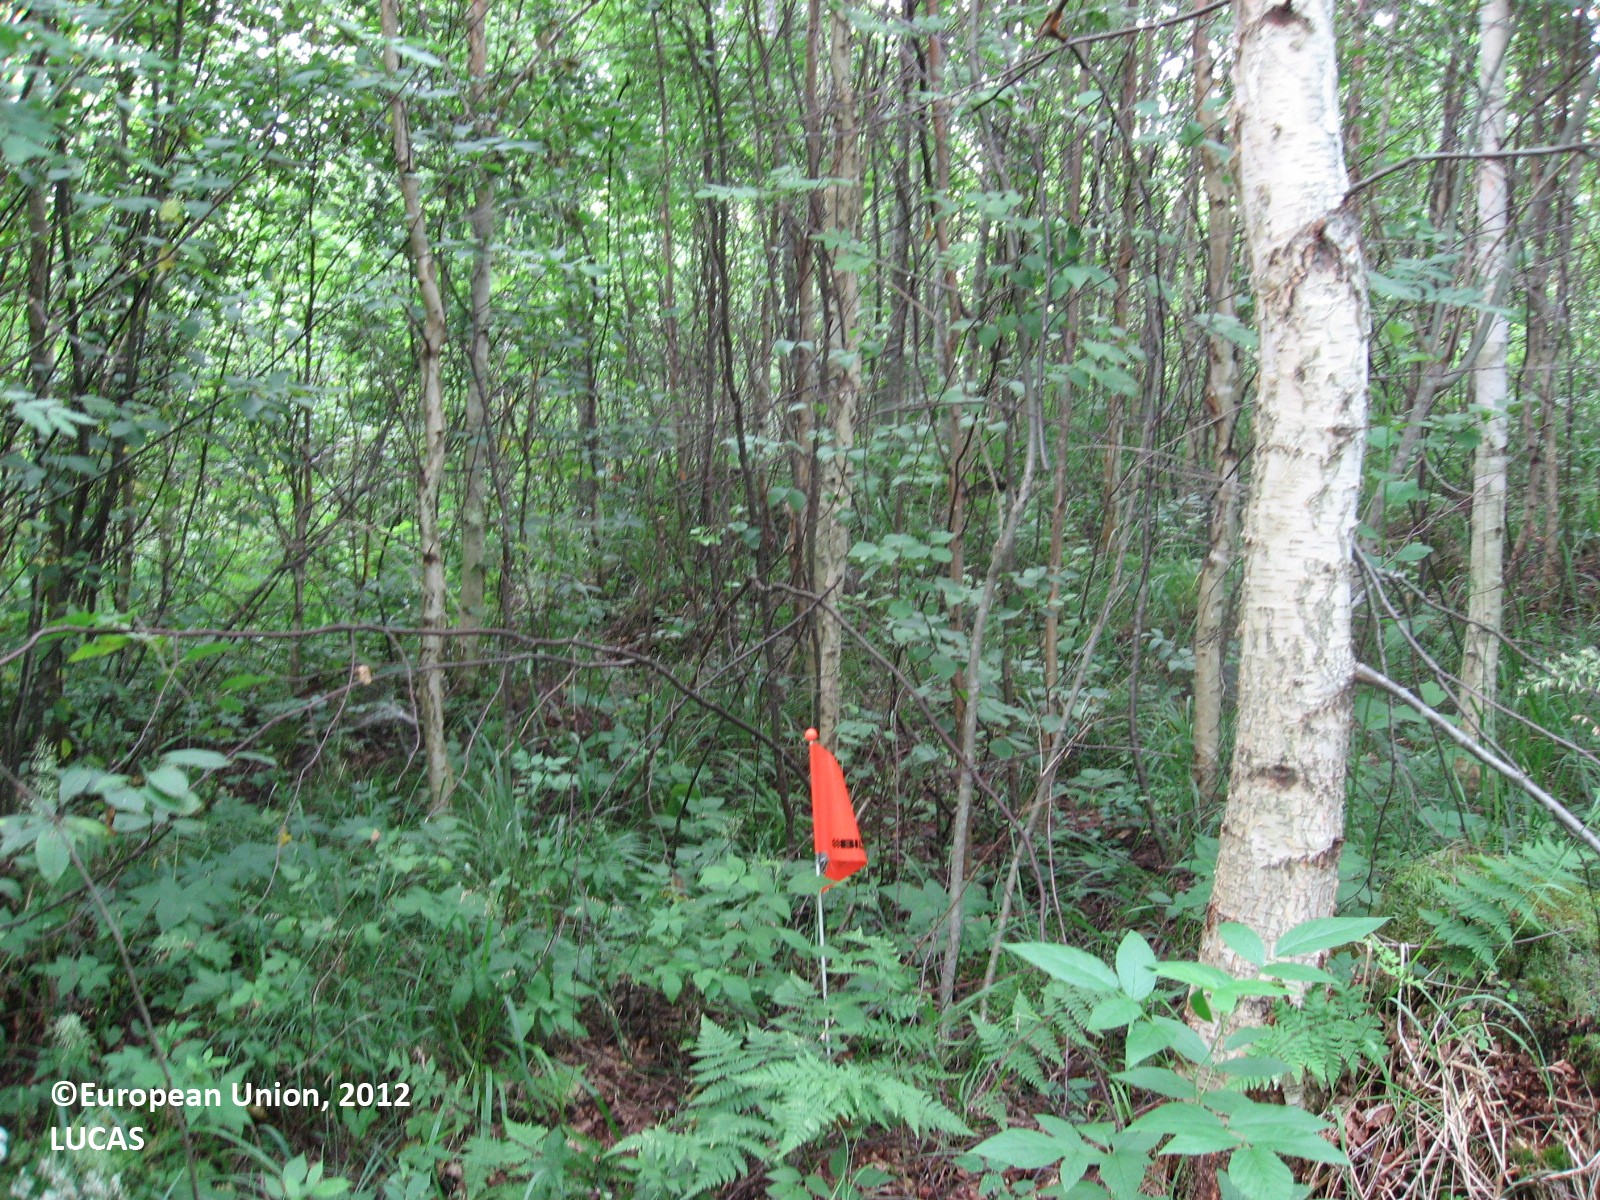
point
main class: Woodland
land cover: Broadleaved woodland
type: boreal forest
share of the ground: > 75 %
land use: Forestry
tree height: > 5 m
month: July
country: FI
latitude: 61.2256
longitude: 25.7164
